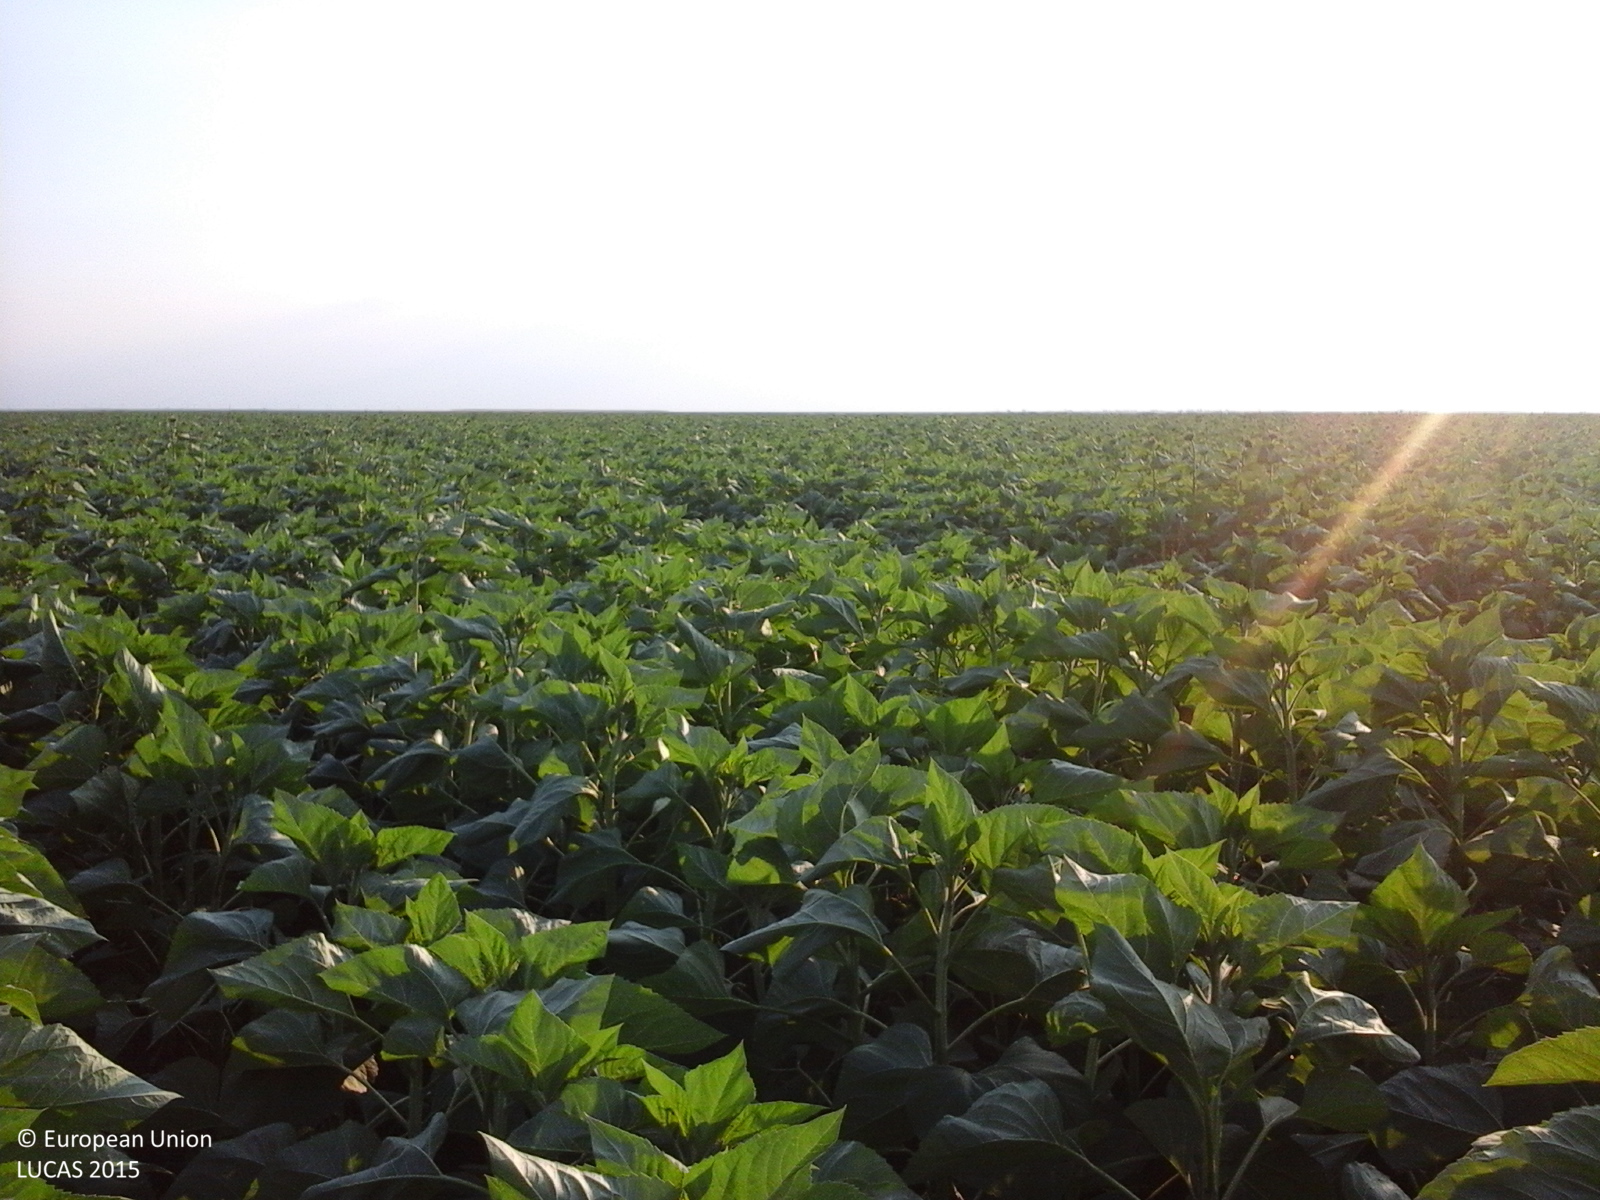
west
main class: Cropland
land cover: Sunflower
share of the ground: > 75 %
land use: Agriculture (excluding fallow land and kitchen gardens)
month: July
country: RO
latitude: 44.0697
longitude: 25.1756
